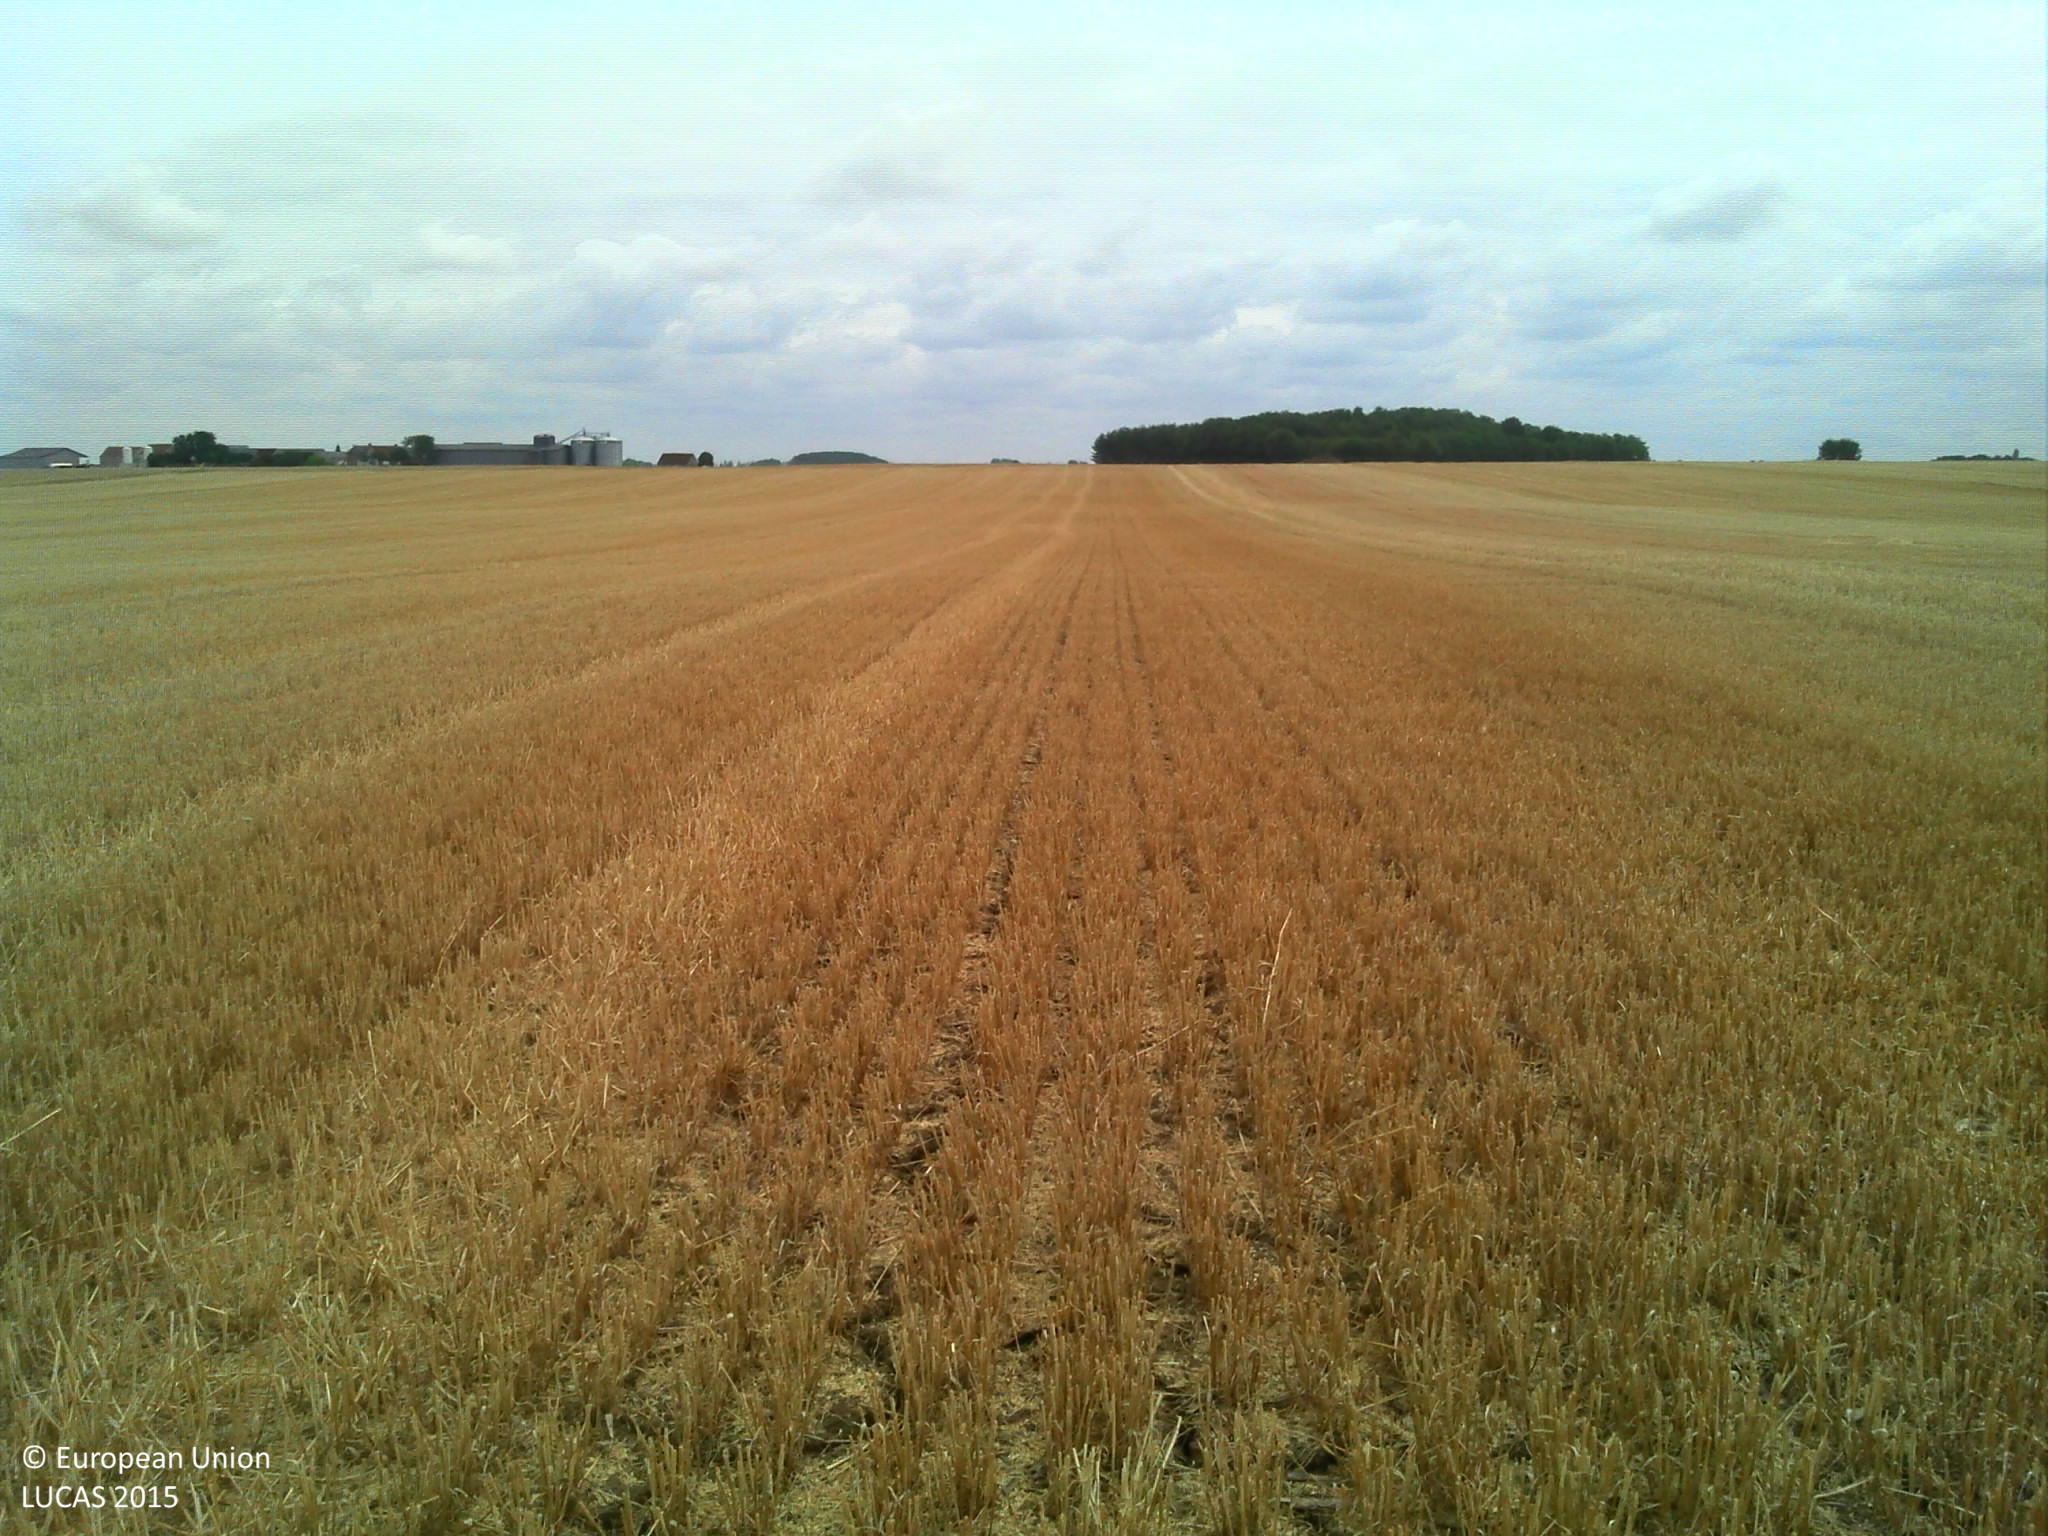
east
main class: Cropland
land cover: Common wheat
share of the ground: > 75 %
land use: Agriculture (excluding fallow land and kitchen gardens)
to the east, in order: Common wheat
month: July
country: FR
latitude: 47.1535
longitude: 0.8428
